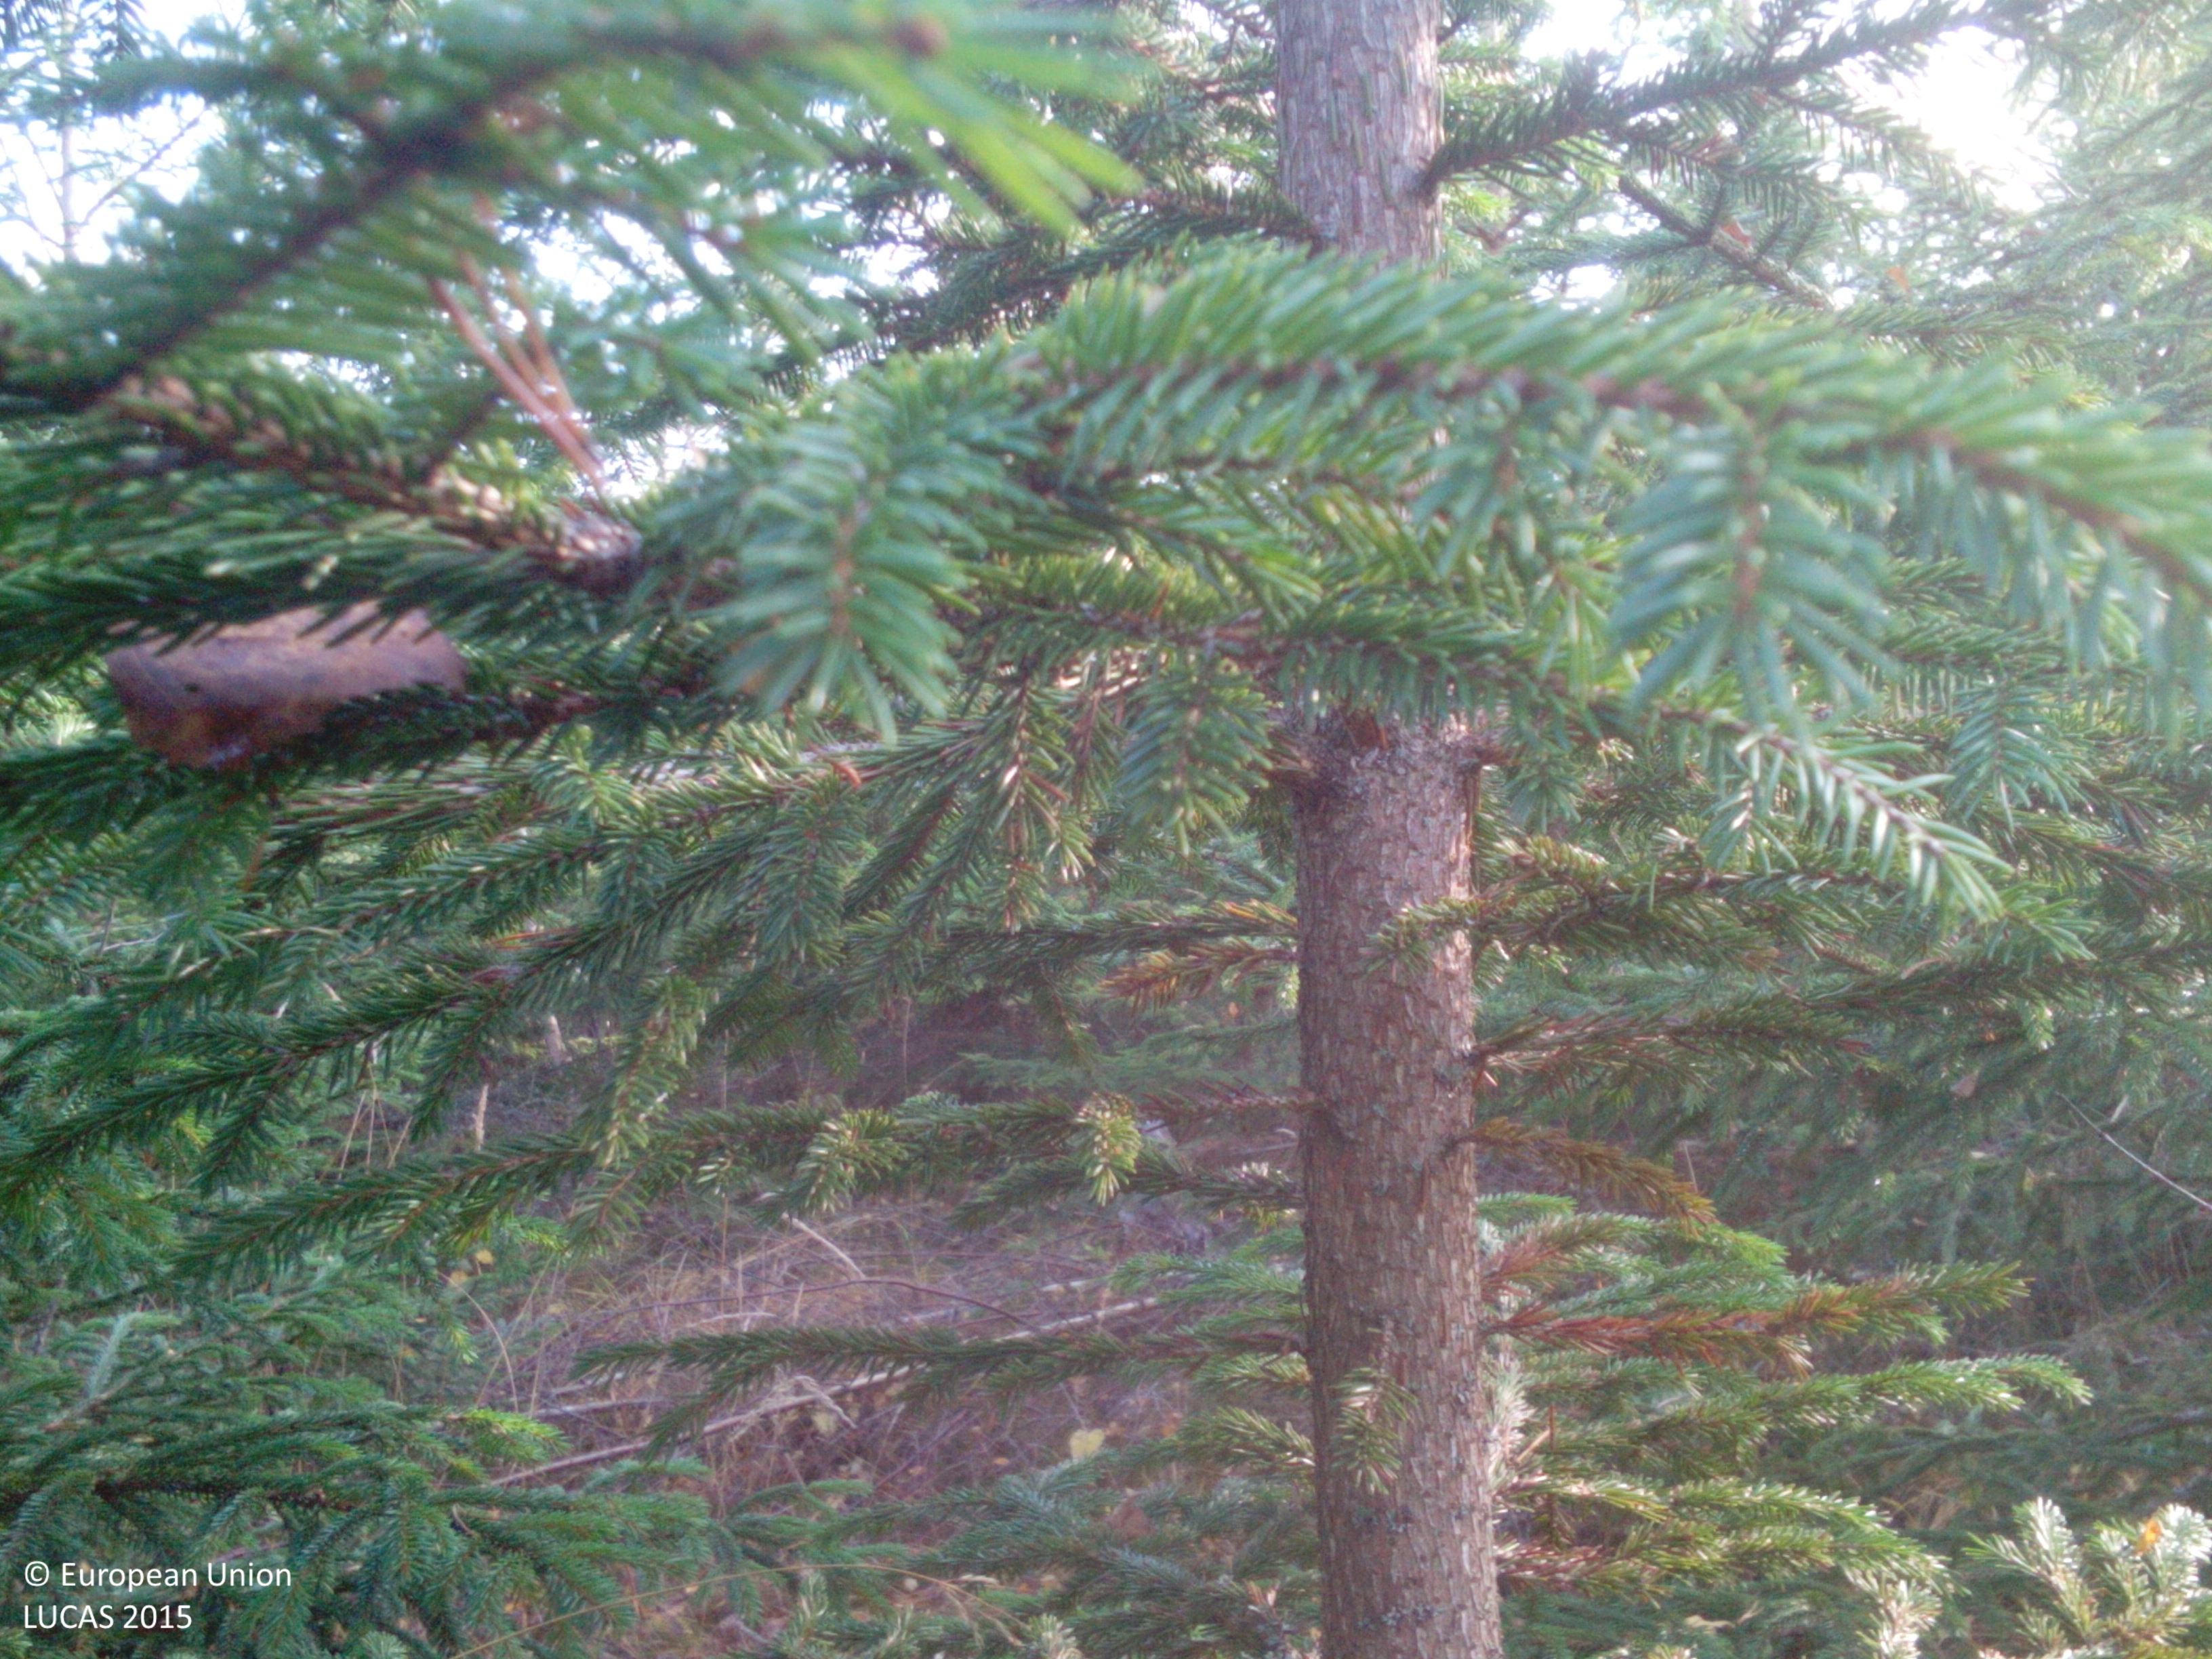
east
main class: Woodland
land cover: Spruce dominated mixed woodland
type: boreal forest
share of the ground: > 75 %
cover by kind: coniferous forest trees 70 %, broadleaved forest trees 25 %, herbaceous plants 5 %
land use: Forestry
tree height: > 5 m
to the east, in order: Spruce dominated mixed woodland; Spruce dominated coniferous woodland; Grassland without tree/shrub cover; Tracks; Grass margins; Grassland without tree/shrub cover
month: October
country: SE
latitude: 59.0114
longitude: 16.6640
